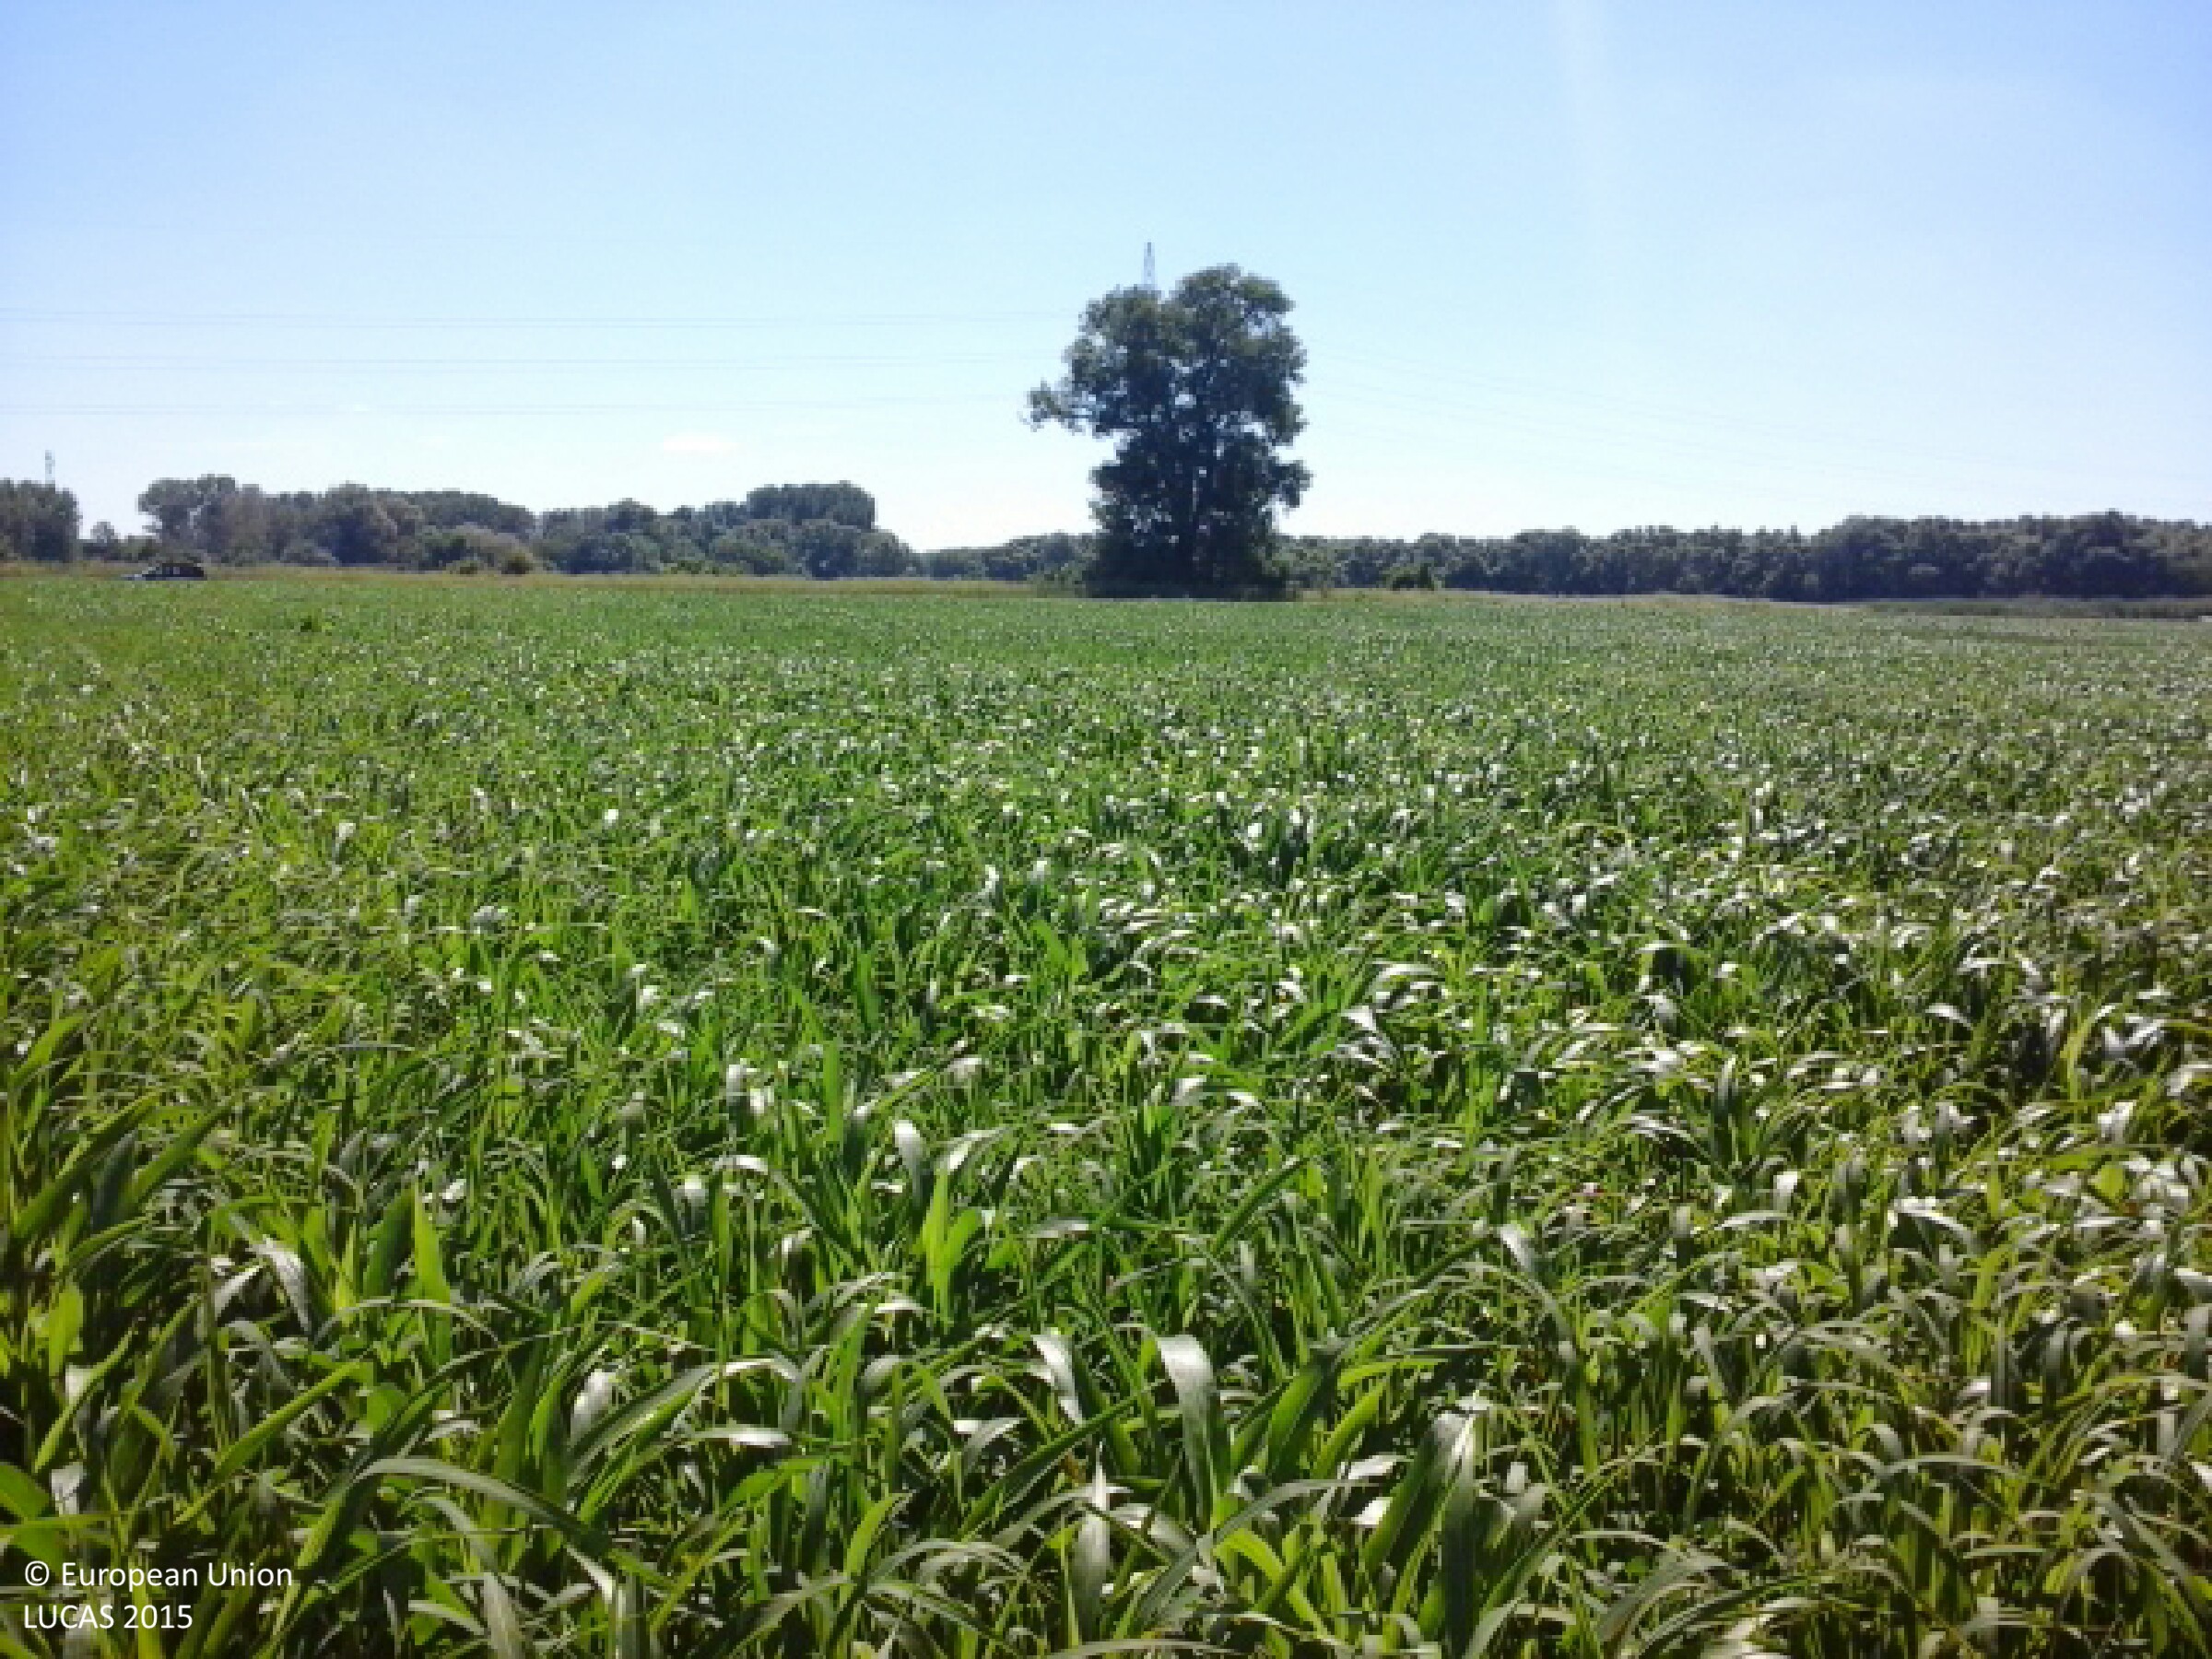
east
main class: Cropland
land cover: Maize
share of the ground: > 75 %
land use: Agriculture (excluding fallow land and kitchen gardens)
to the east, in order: Maize; Tracks; Spontaneously vegetated surfaces; Electric lines; Spontaneously vegetated surfaces
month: July
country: HU
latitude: 48.2329
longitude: 22.0494
